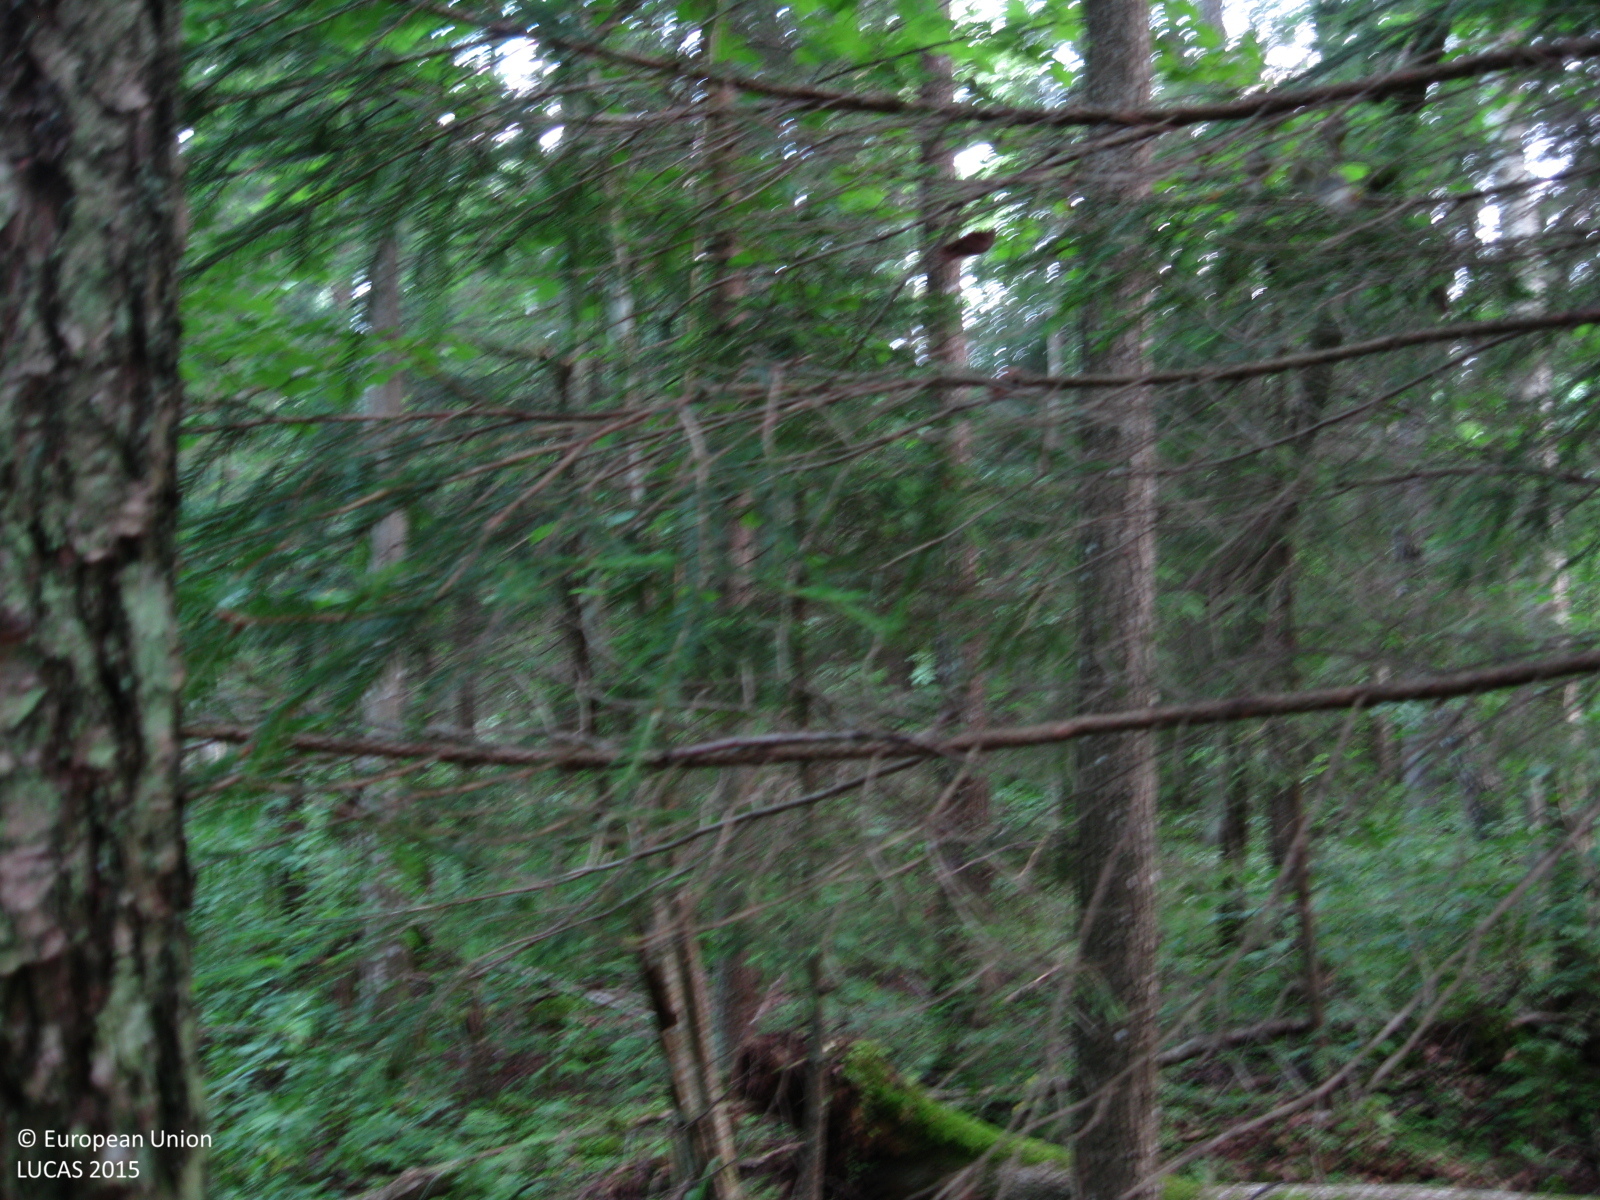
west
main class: Woodland
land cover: Spruce dominated mixed woodland
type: hemiboreal forest and nemoral coniferous forest and mixed broadleaved-coniferous forest
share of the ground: > 75 %
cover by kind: coniferous forest trees 45 %, broadleaved forest trees 35 %, herbaceous plants 10 %, shrubs 5 %, unconsolidated bare surface 5 %
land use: Forestry
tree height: > 5 m
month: July
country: LT
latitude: 55.3995
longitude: 24.6145
